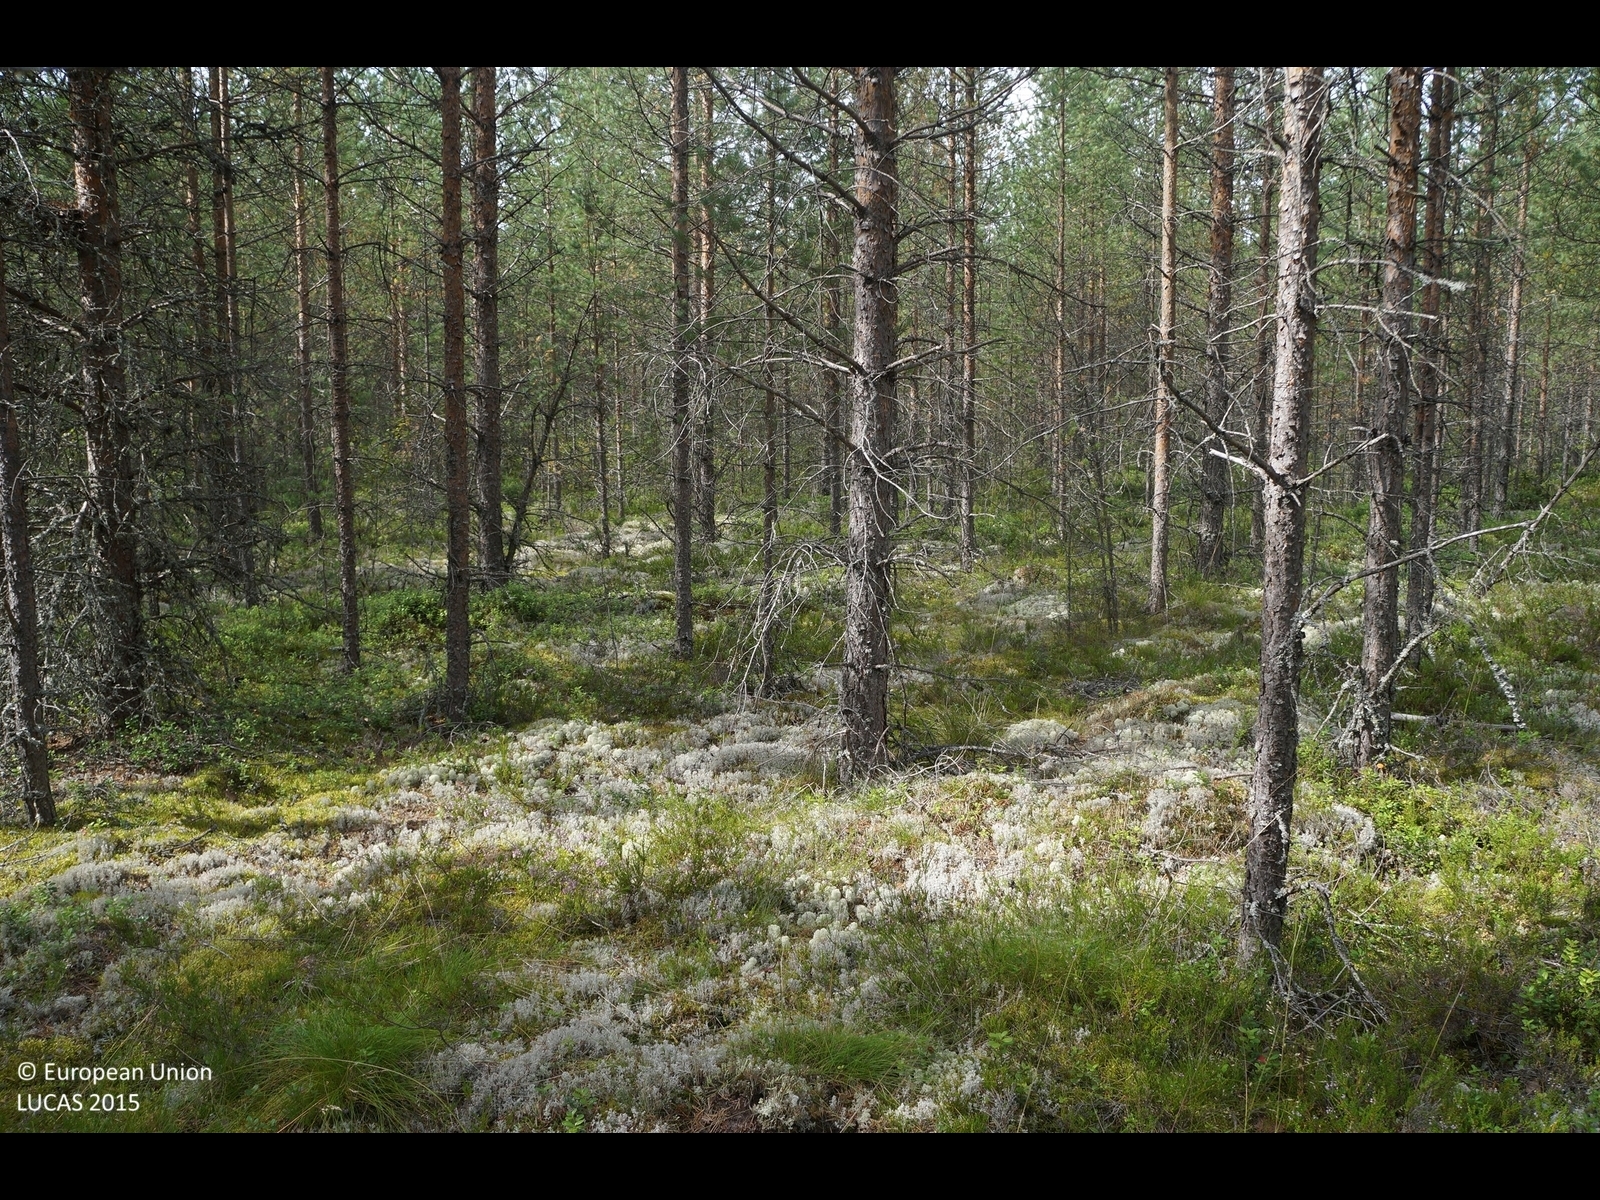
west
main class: Woodland
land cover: Pine dominated coniferous woodland
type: boreal forest
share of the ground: 50 - 75 %
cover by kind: coniferous forest trees 60 %, shrubs 20 %, lichens and mosses 20 %
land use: Forestry
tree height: > 5 m
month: August
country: FI
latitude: 64.7932
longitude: 24.7382
